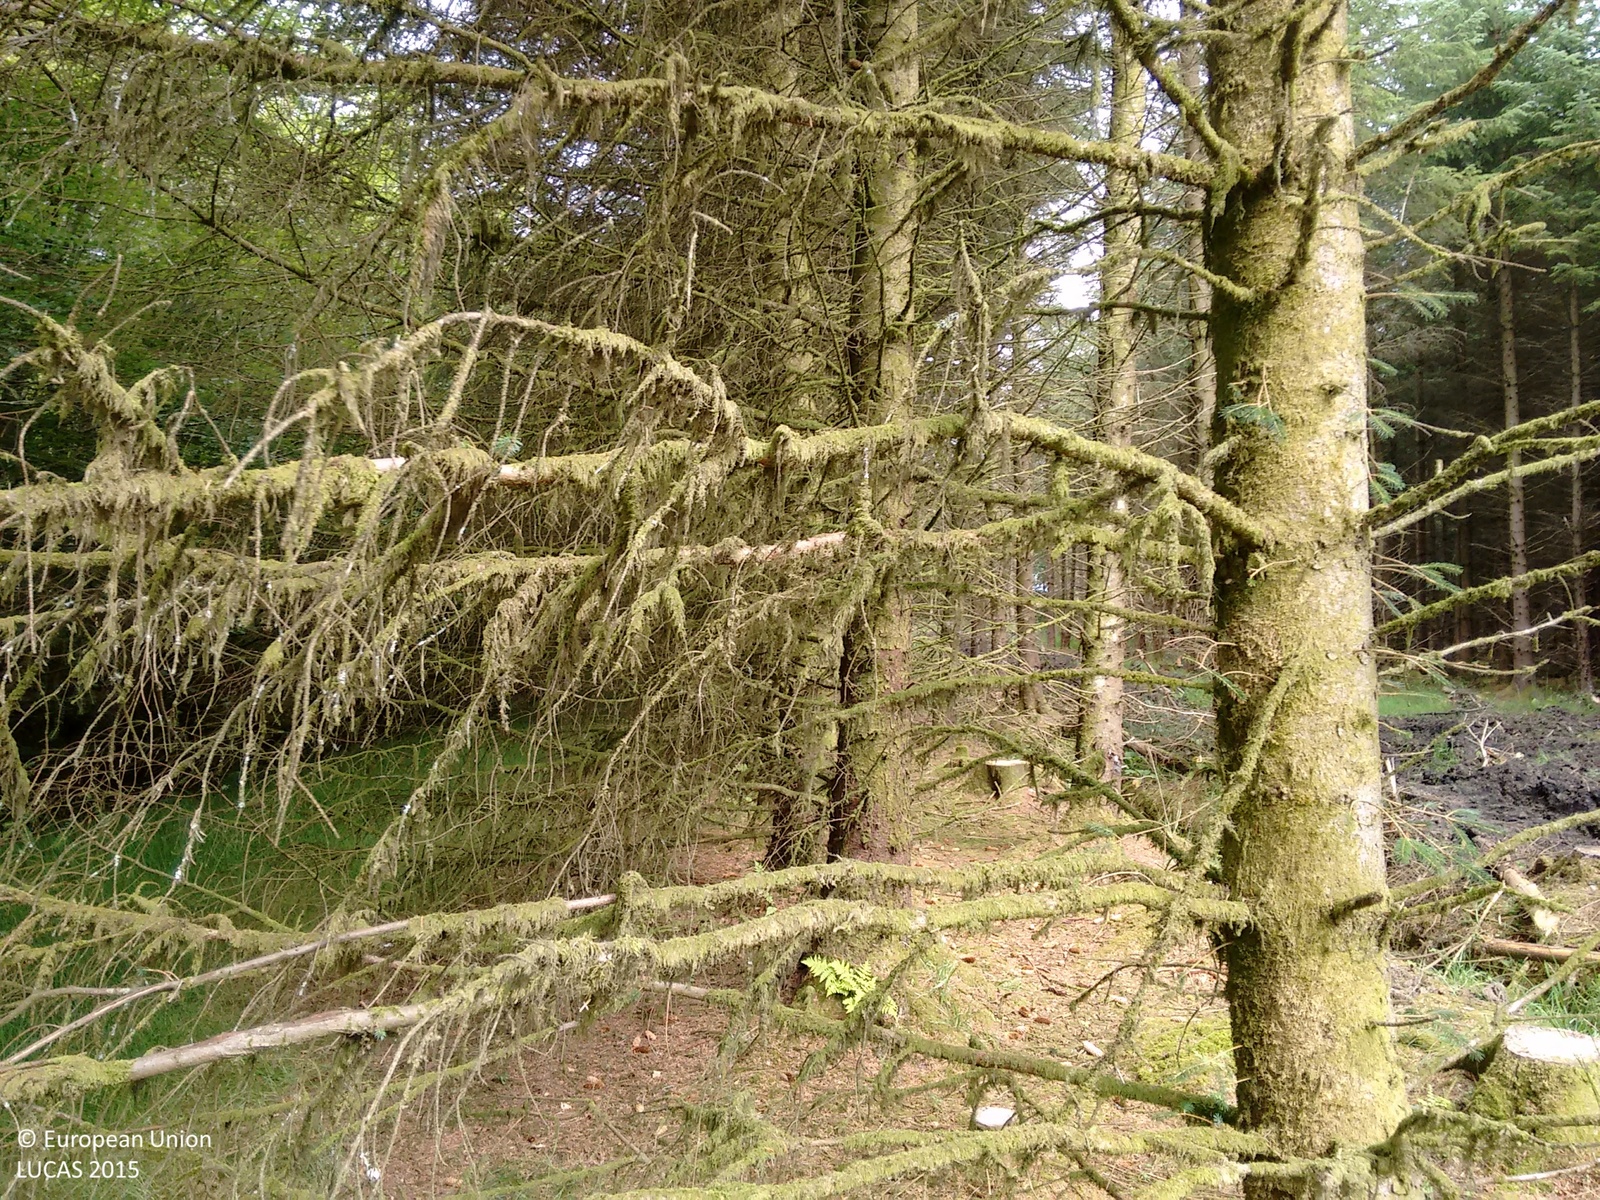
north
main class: Woodland
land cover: Spruce dominated coniferous woodland
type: exotic forest
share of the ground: > 75 %
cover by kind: coniferous forest trees 80 %, broadleaved forest trees 20 %
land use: Forestry
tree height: > 5 m
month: August
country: IE
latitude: 53.0425
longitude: -7.5669
